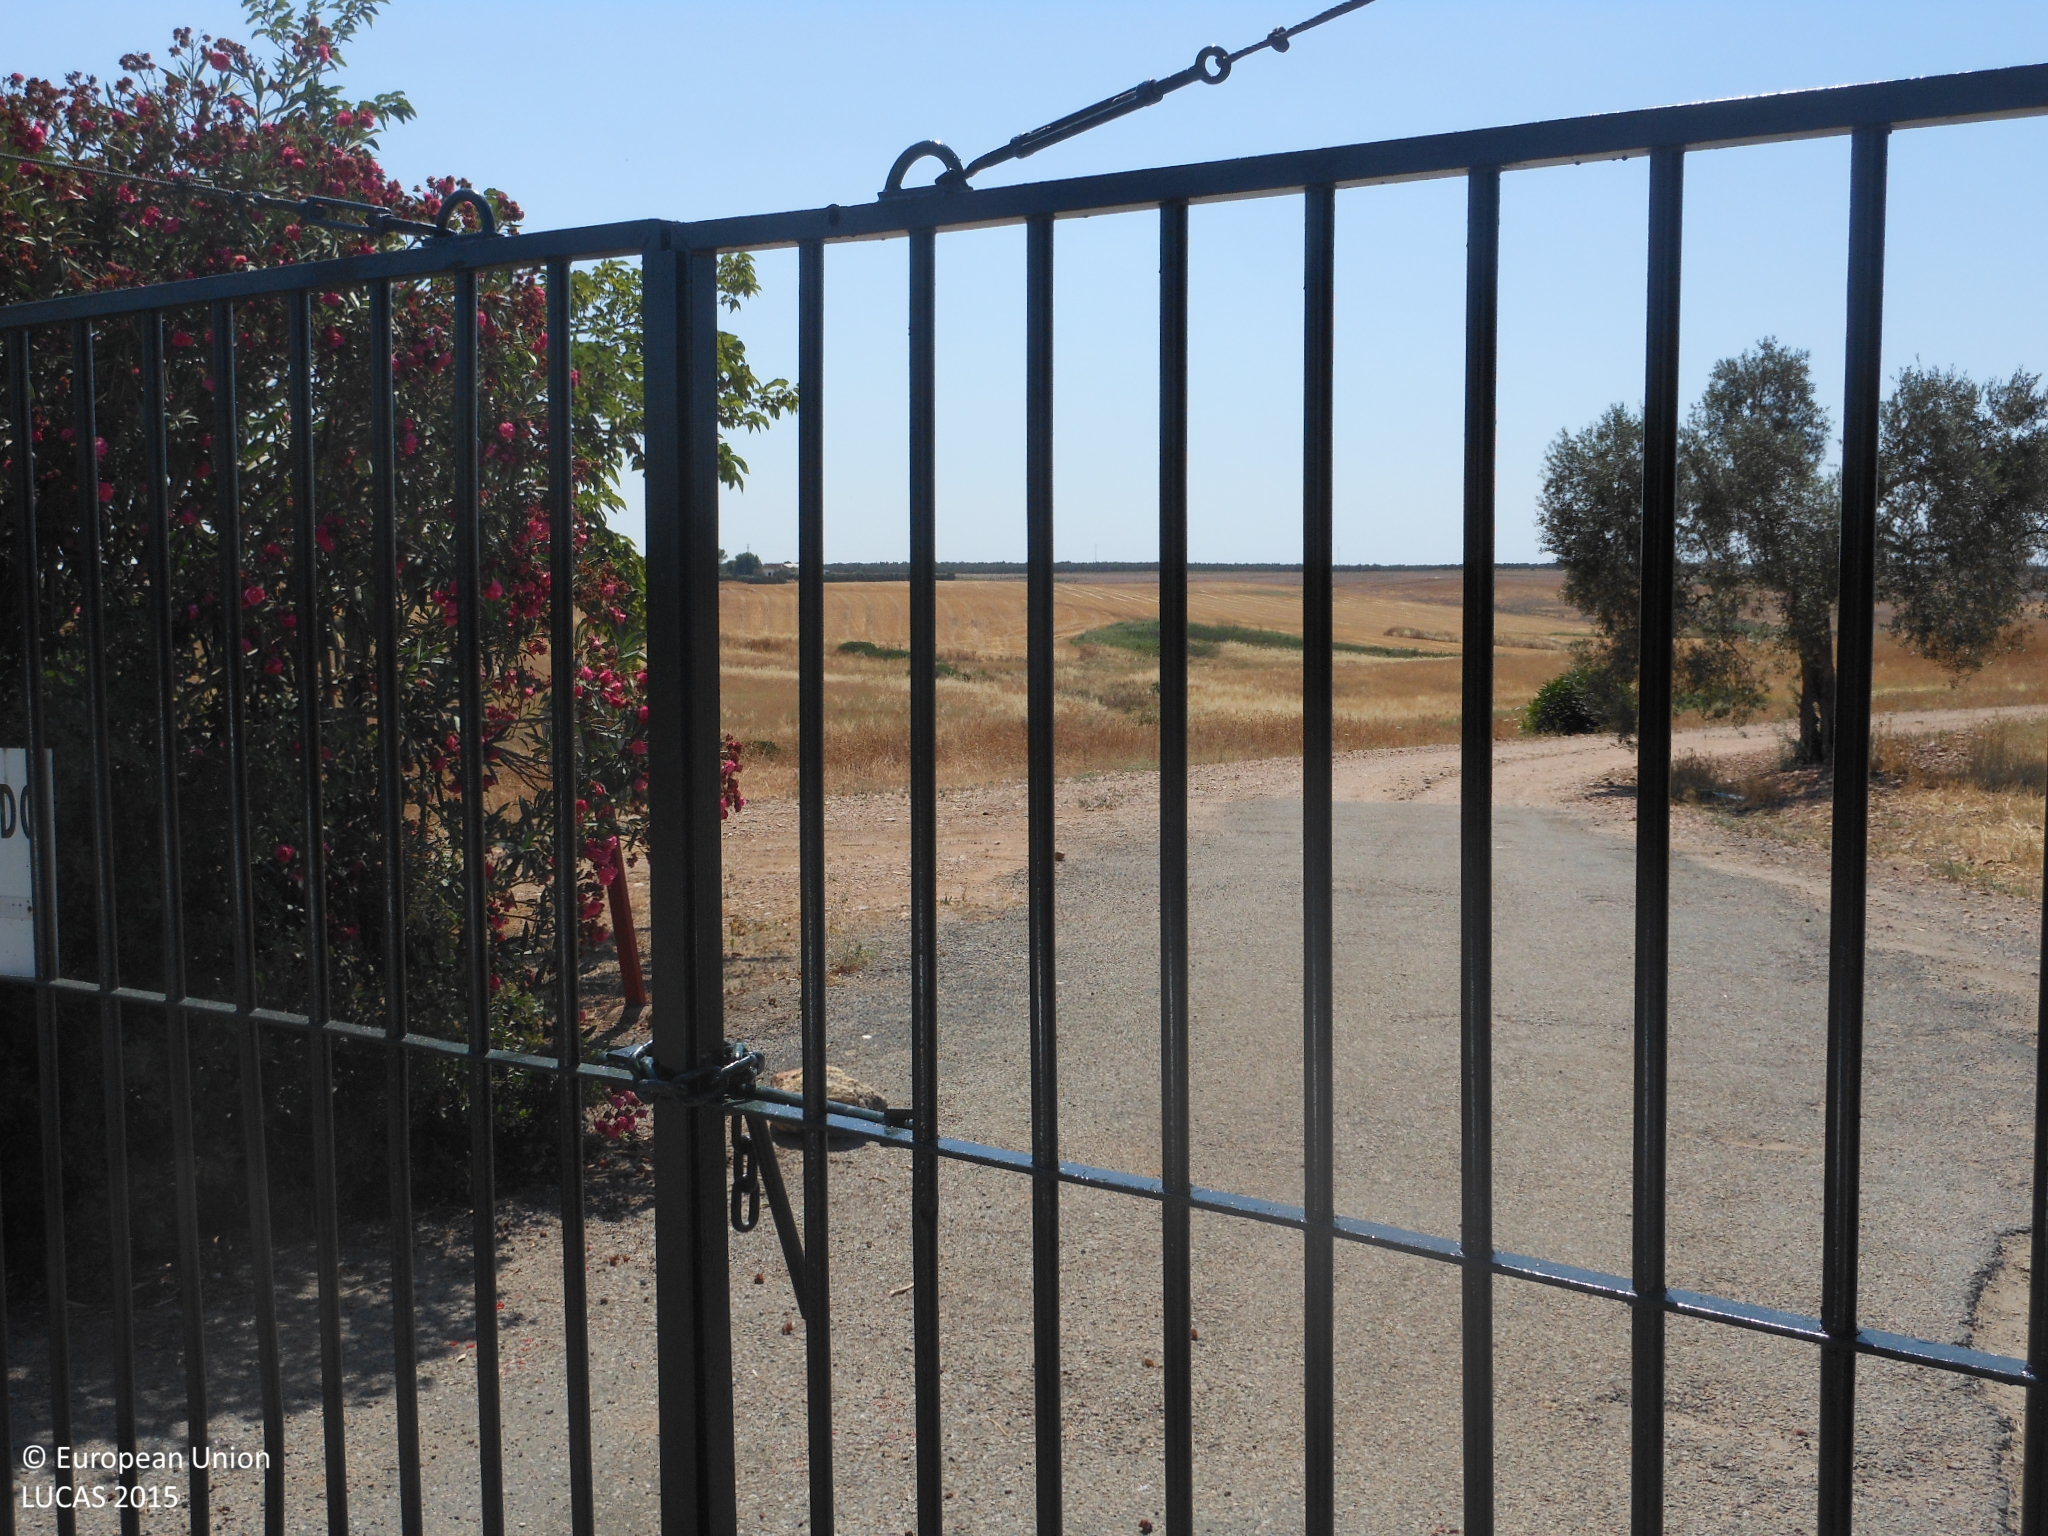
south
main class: Cropland
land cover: Arable land (only in case pi)
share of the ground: > 75 %
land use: Agriculture (excluding fallow land and kitchen gardens)
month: June
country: ES
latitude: 37.5348
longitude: -5.5115
